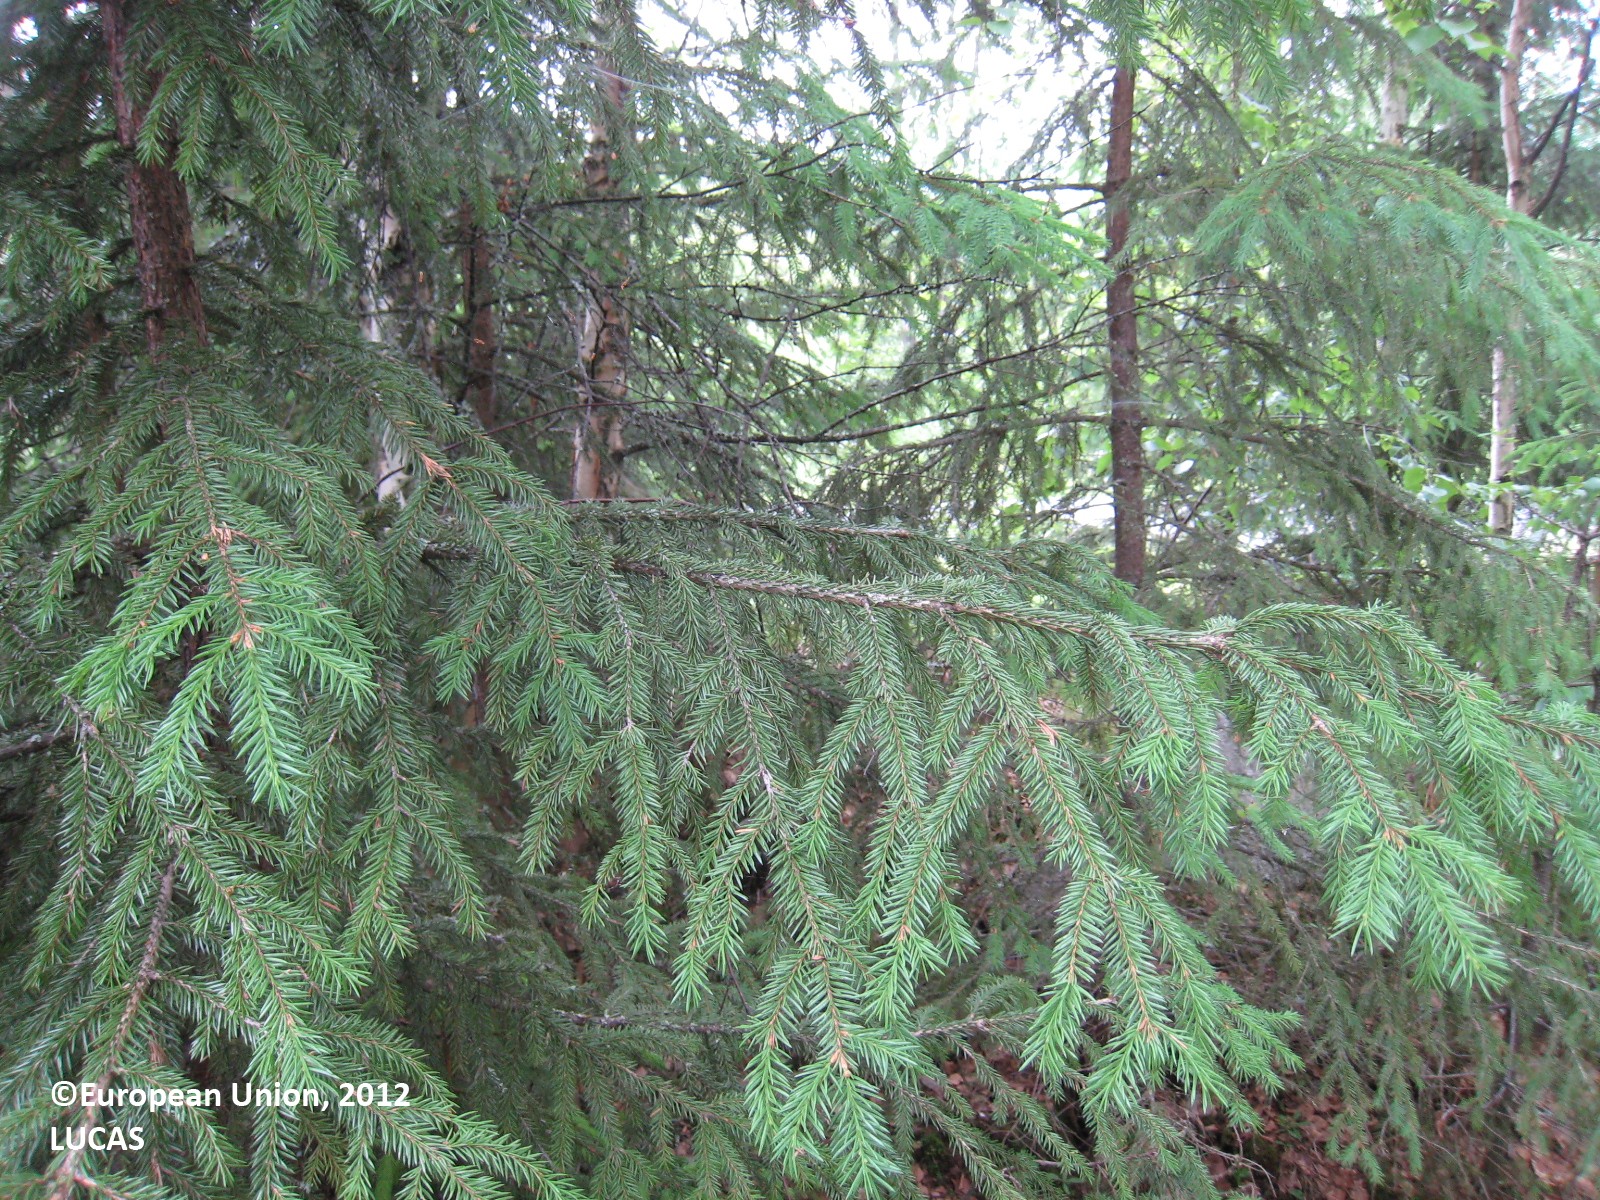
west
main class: Woodland
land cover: Other mixed woodland
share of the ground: > 75 %
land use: Forestry
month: June
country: FI
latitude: 62.1044
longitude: 26.2870
